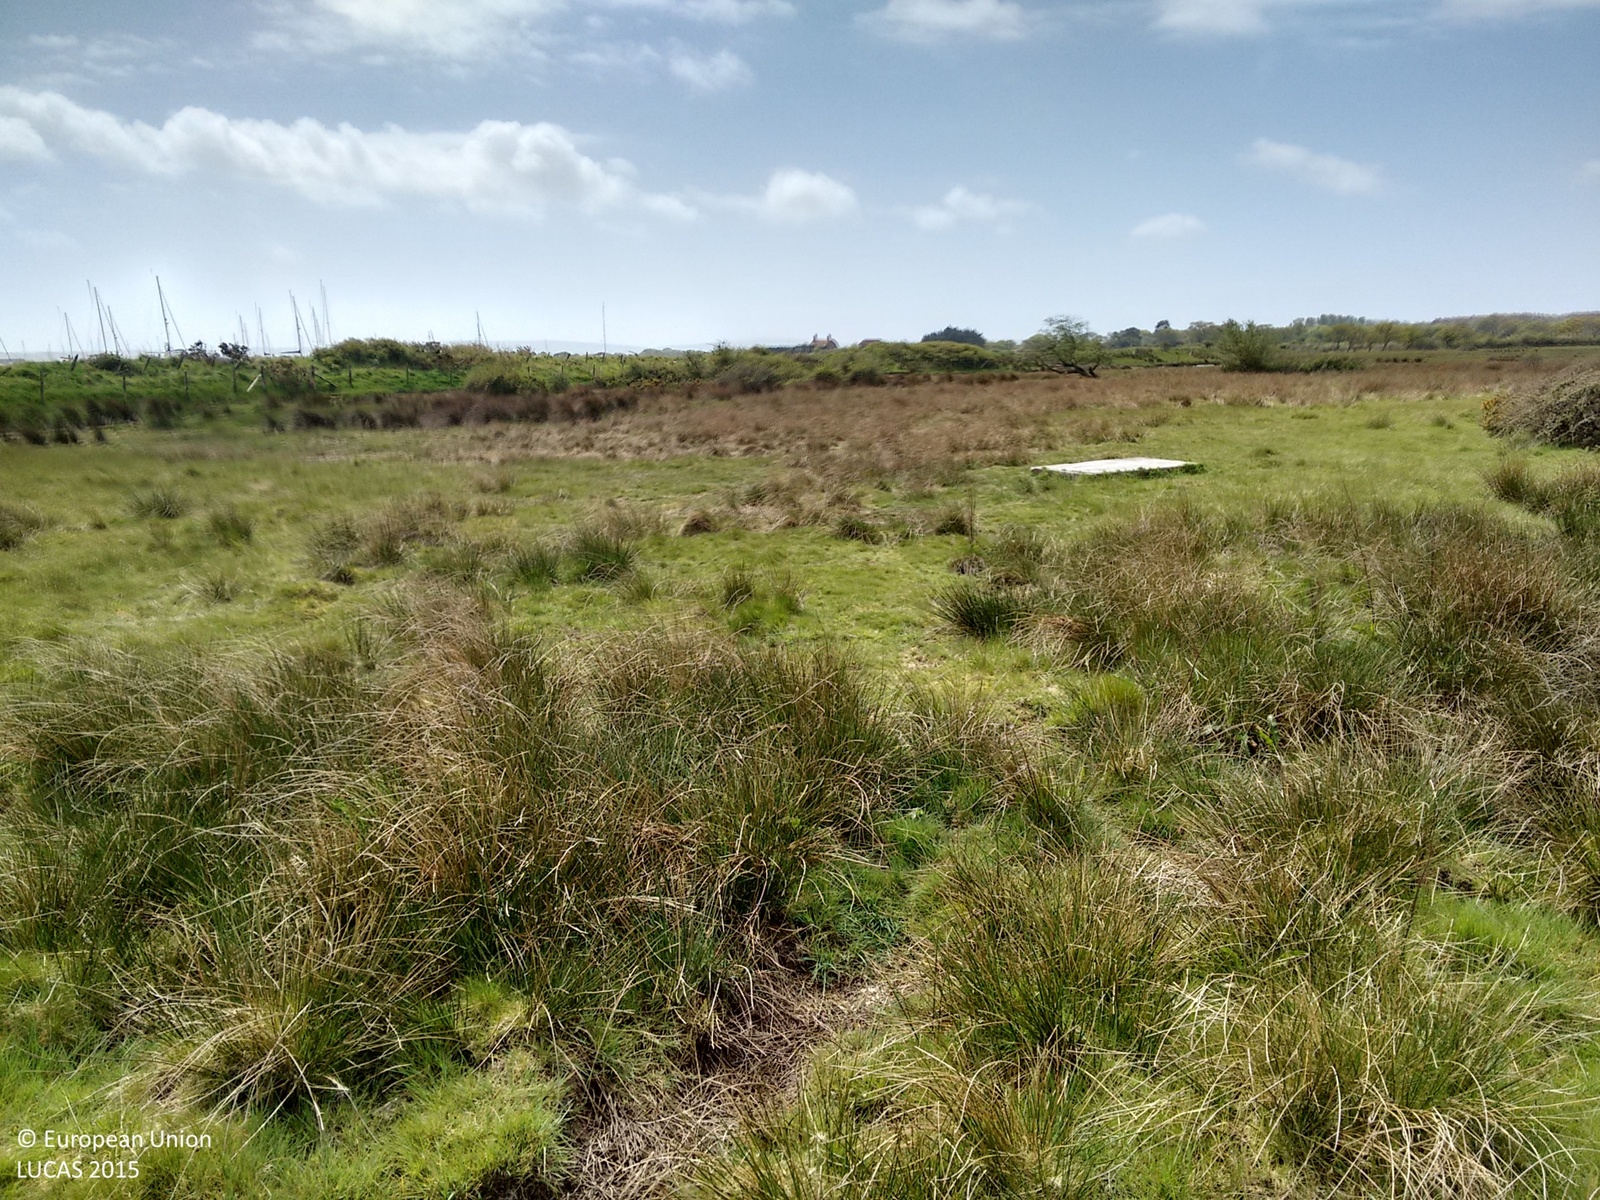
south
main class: Grassland
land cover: Grassland without tree/shrub cover
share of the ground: > 75 %
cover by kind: herbaceous plants 100 %
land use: Agriculture (excluding fallow land and kitchen gardens)
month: May
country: GB
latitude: 50.7897
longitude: -1.4123
